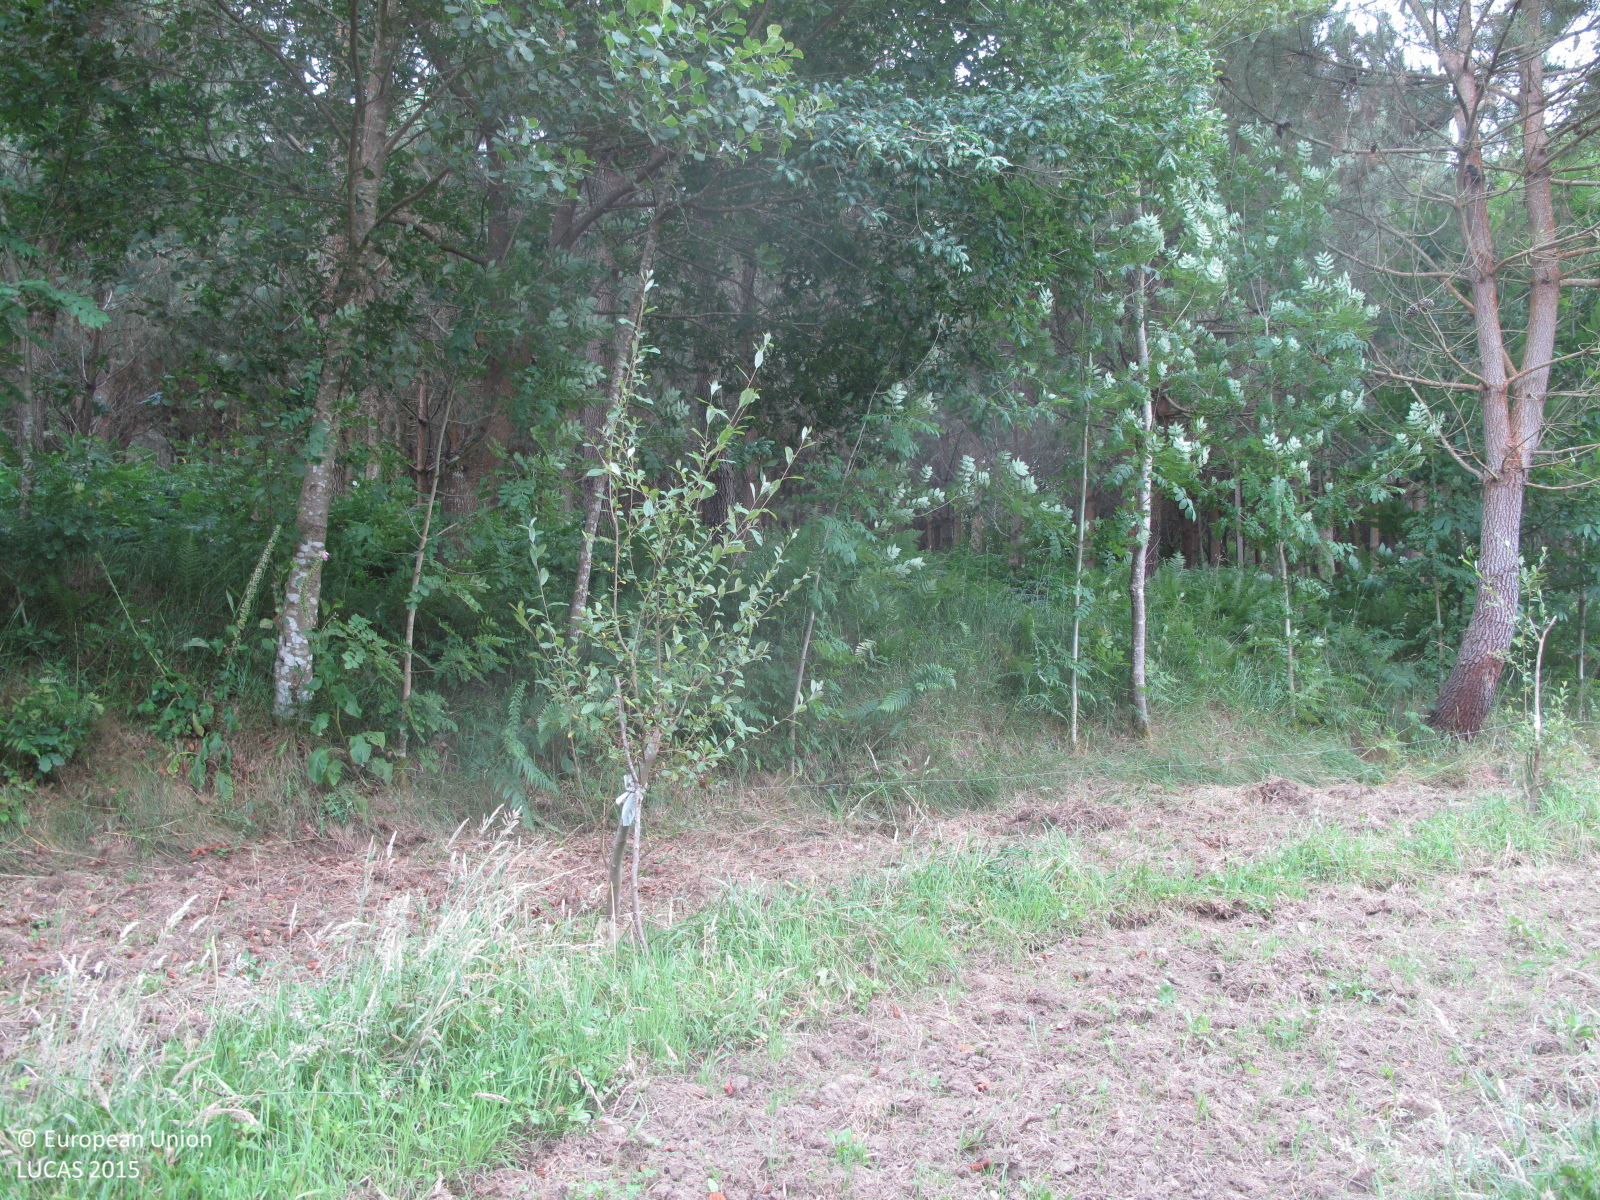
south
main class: Grassland
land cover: Grassland without tree/shrub cover
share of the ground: > 75 %
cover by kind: herbaceous plants 80 %, unconsolidated bare surface 20 %
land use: Agriculture (excluding fallow land and kitchen gardens)
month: July
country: ES
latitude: 43.2293
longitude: -8.5668
